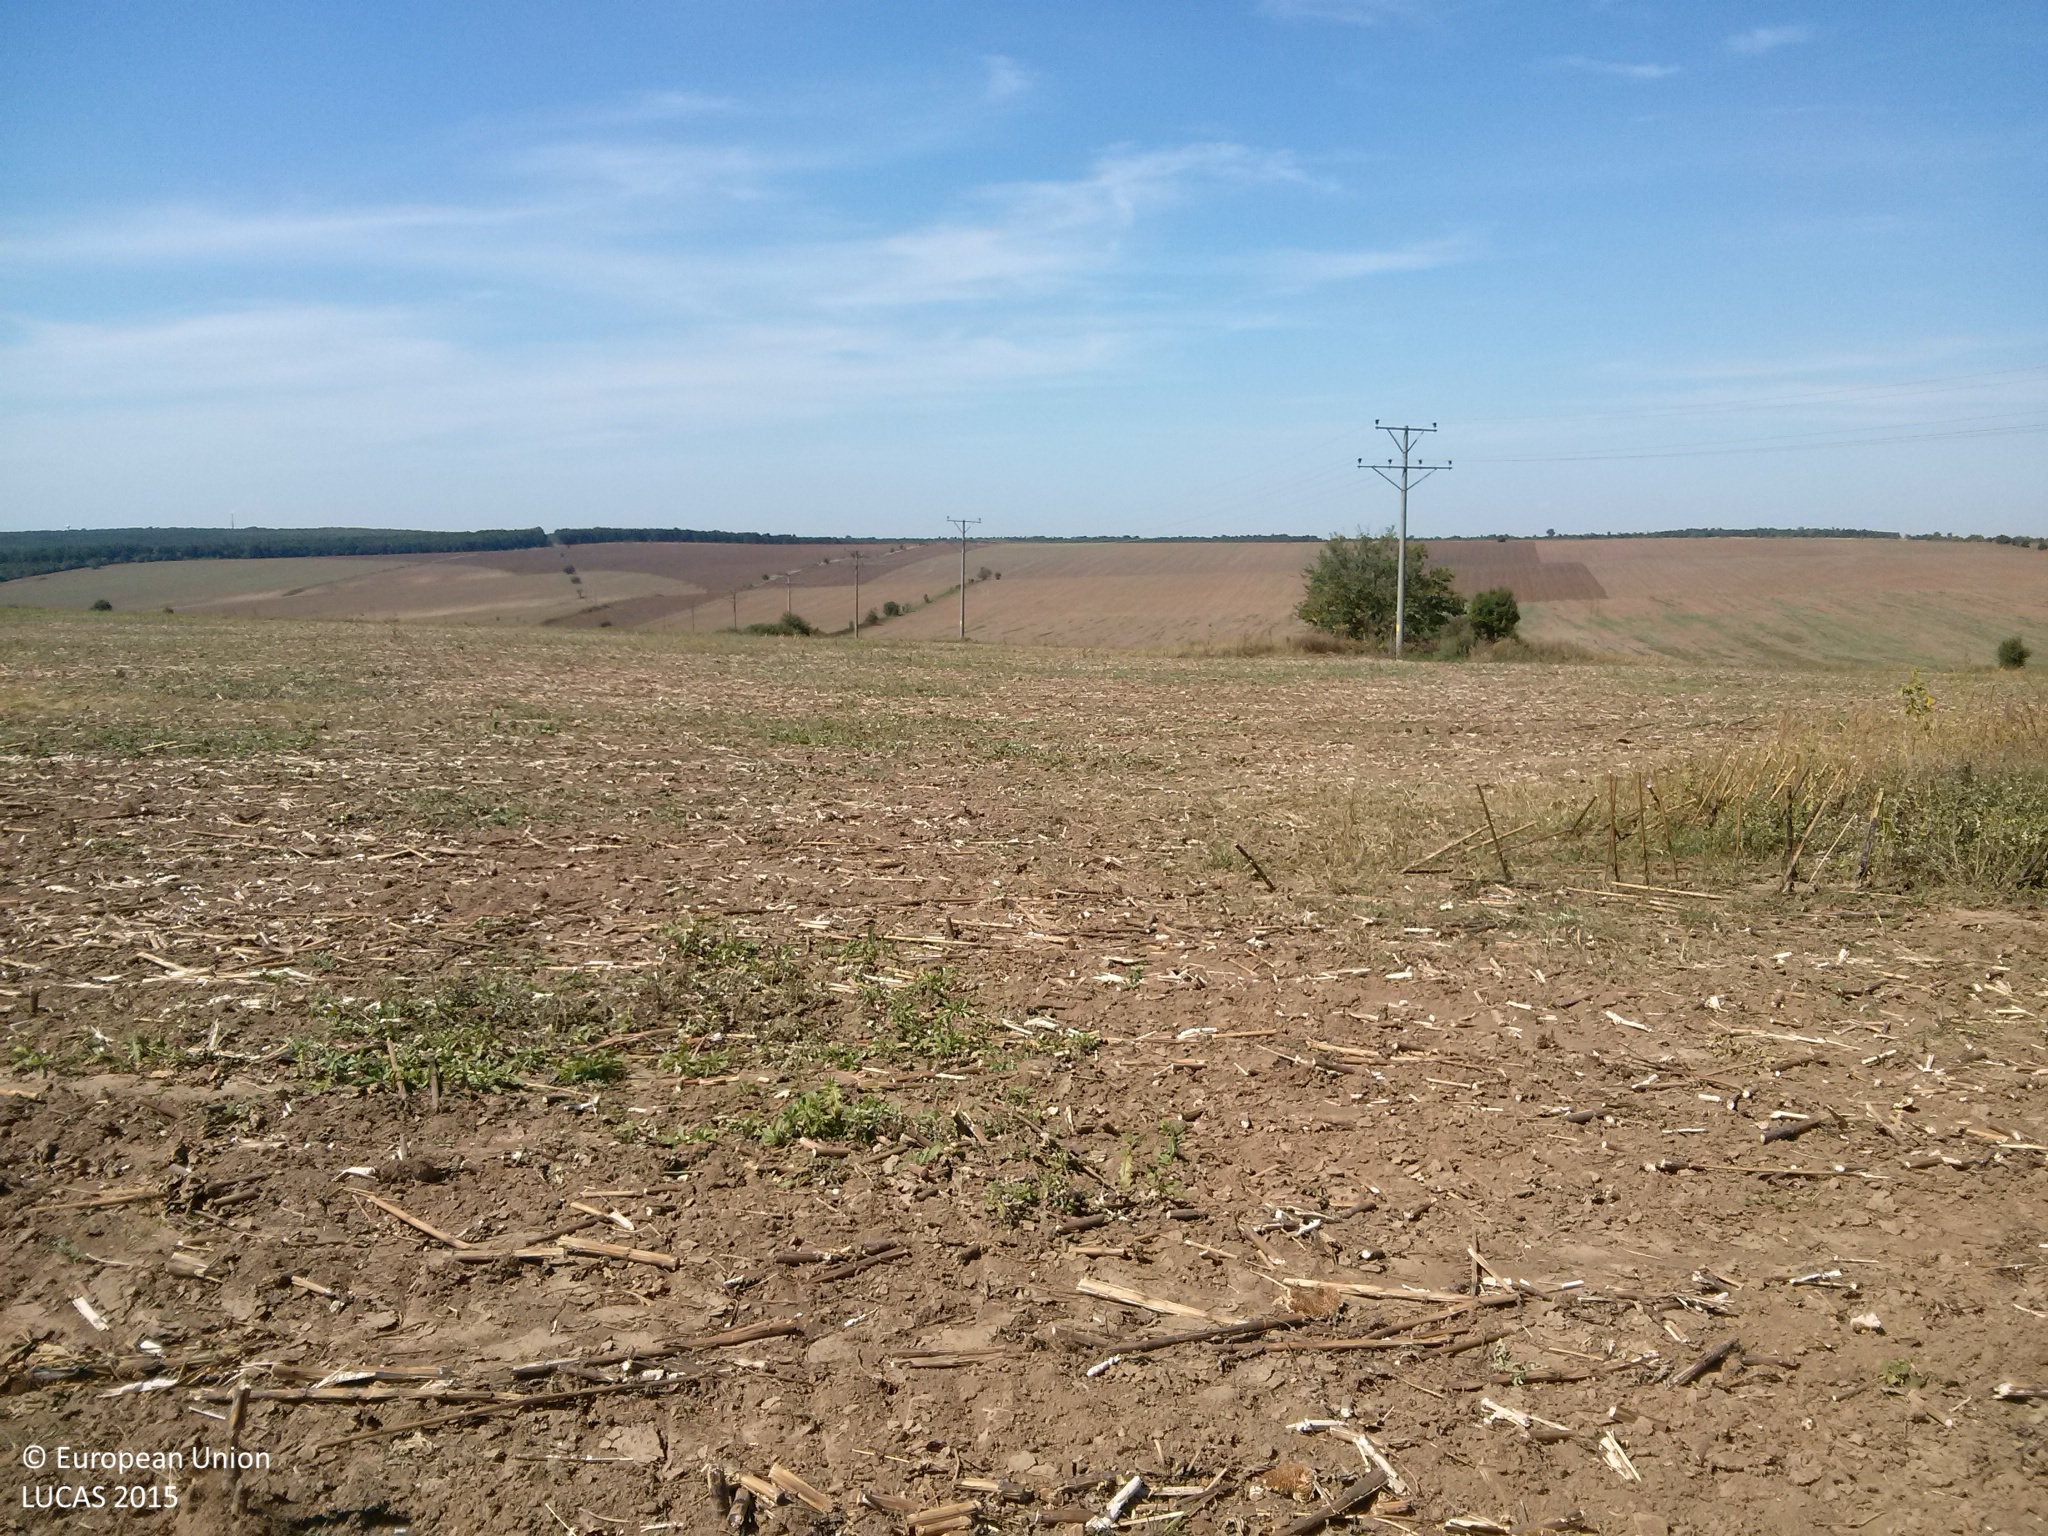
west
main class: Cropland
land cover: Sunflower
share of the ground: < 10 %
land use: Agriculture (excluding fallow land and kitchen gardens)
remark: Harvested field
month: September
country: BG
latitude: 43.6699
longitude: 26.3372
